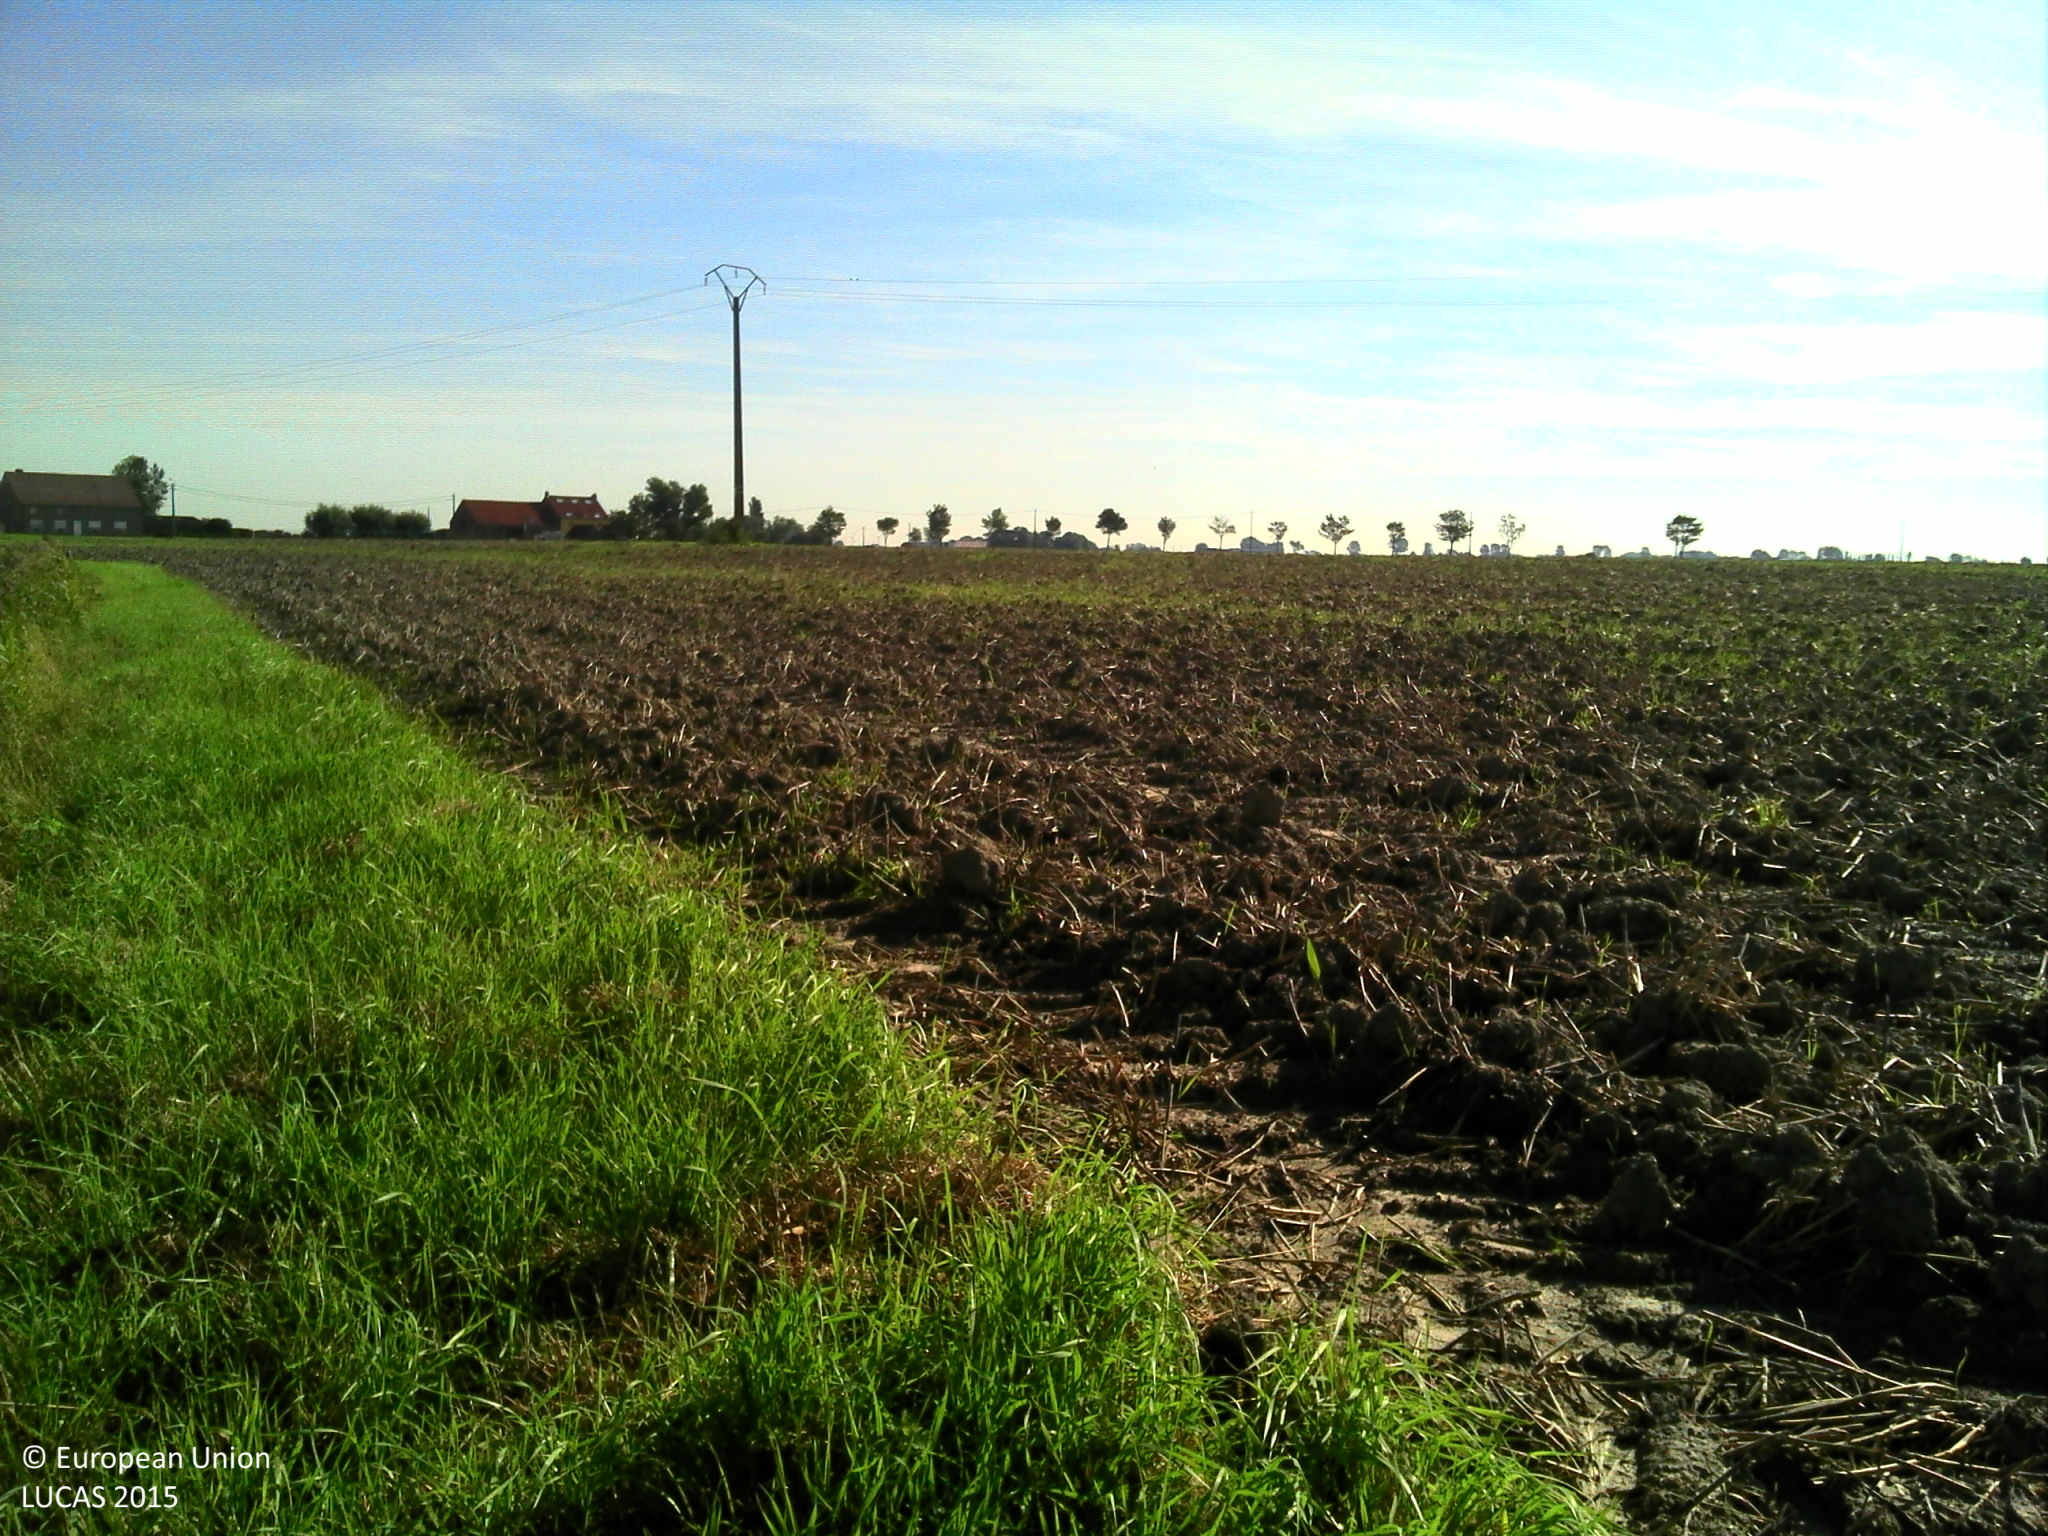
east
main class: Grassland
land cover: Grassland without tree/shrub cover
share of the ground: > 75 %
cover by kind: herbaceous plants 100 %
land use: Agriculture (excluding fallow land and kitchen gardens)
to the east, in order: Grass margins; Inland fresh running water; Grass margins; Common wheat; Electric lines; Common wheat
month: September
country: BE
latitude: 51.1479
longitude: 2.7983
